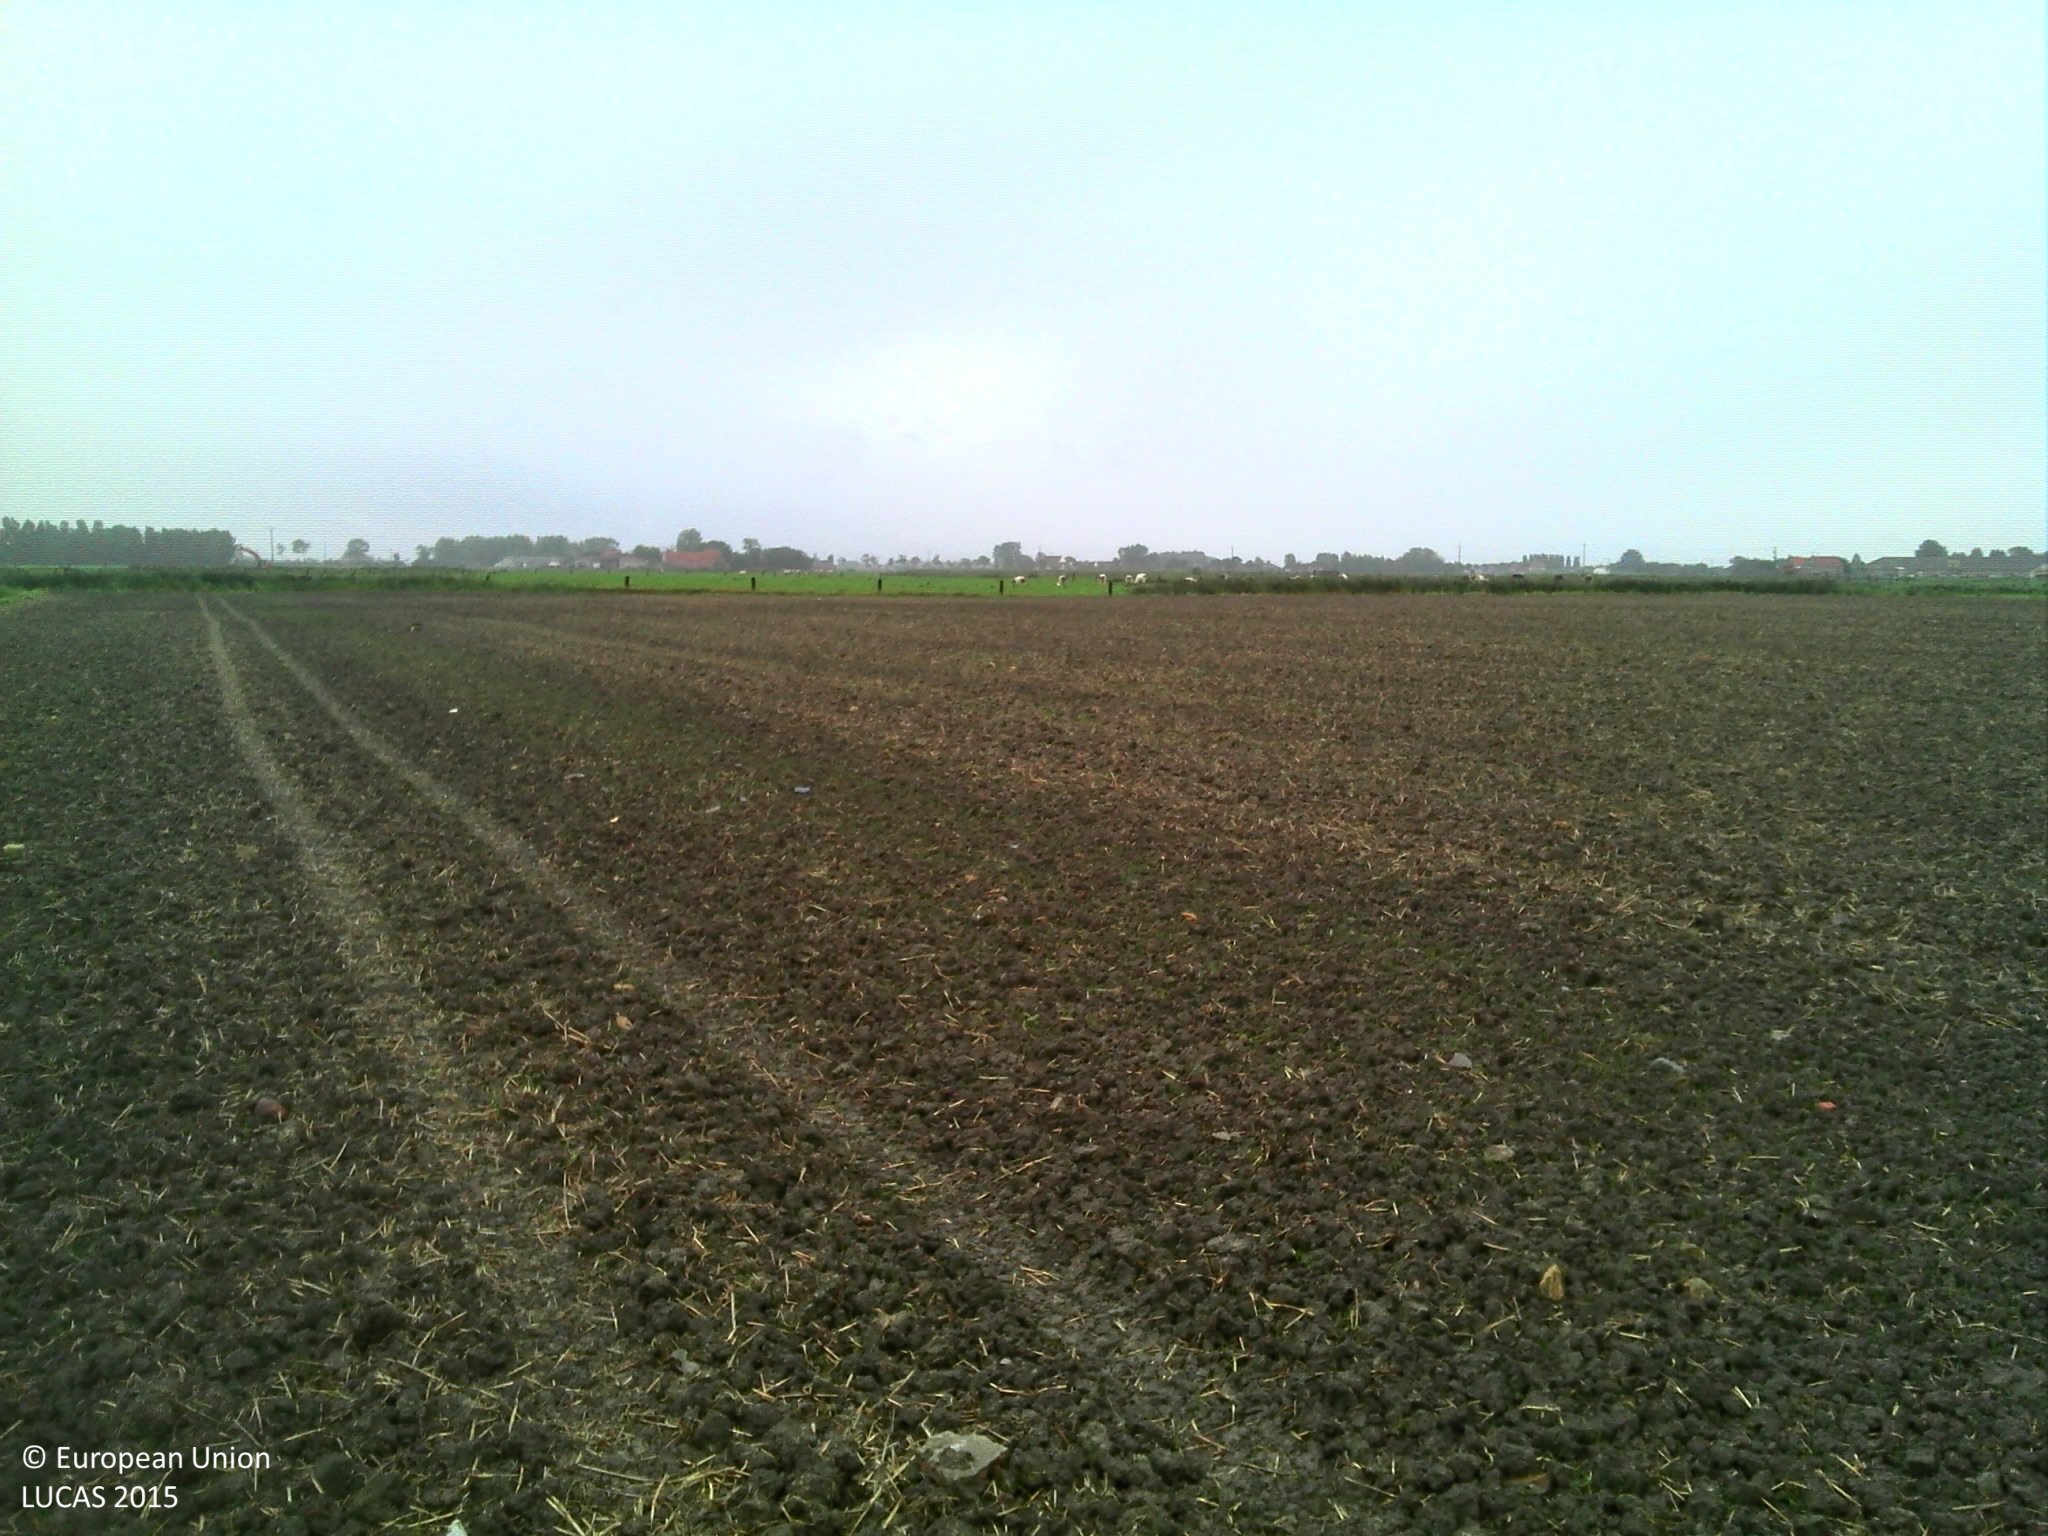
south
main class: Cropland
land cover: Temporary grasslands
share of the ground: < 10 %
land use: Agriculture (excluding fallow land and kitchen gardens)
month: September
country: BE
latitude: 51.1139
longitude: 2.8323
